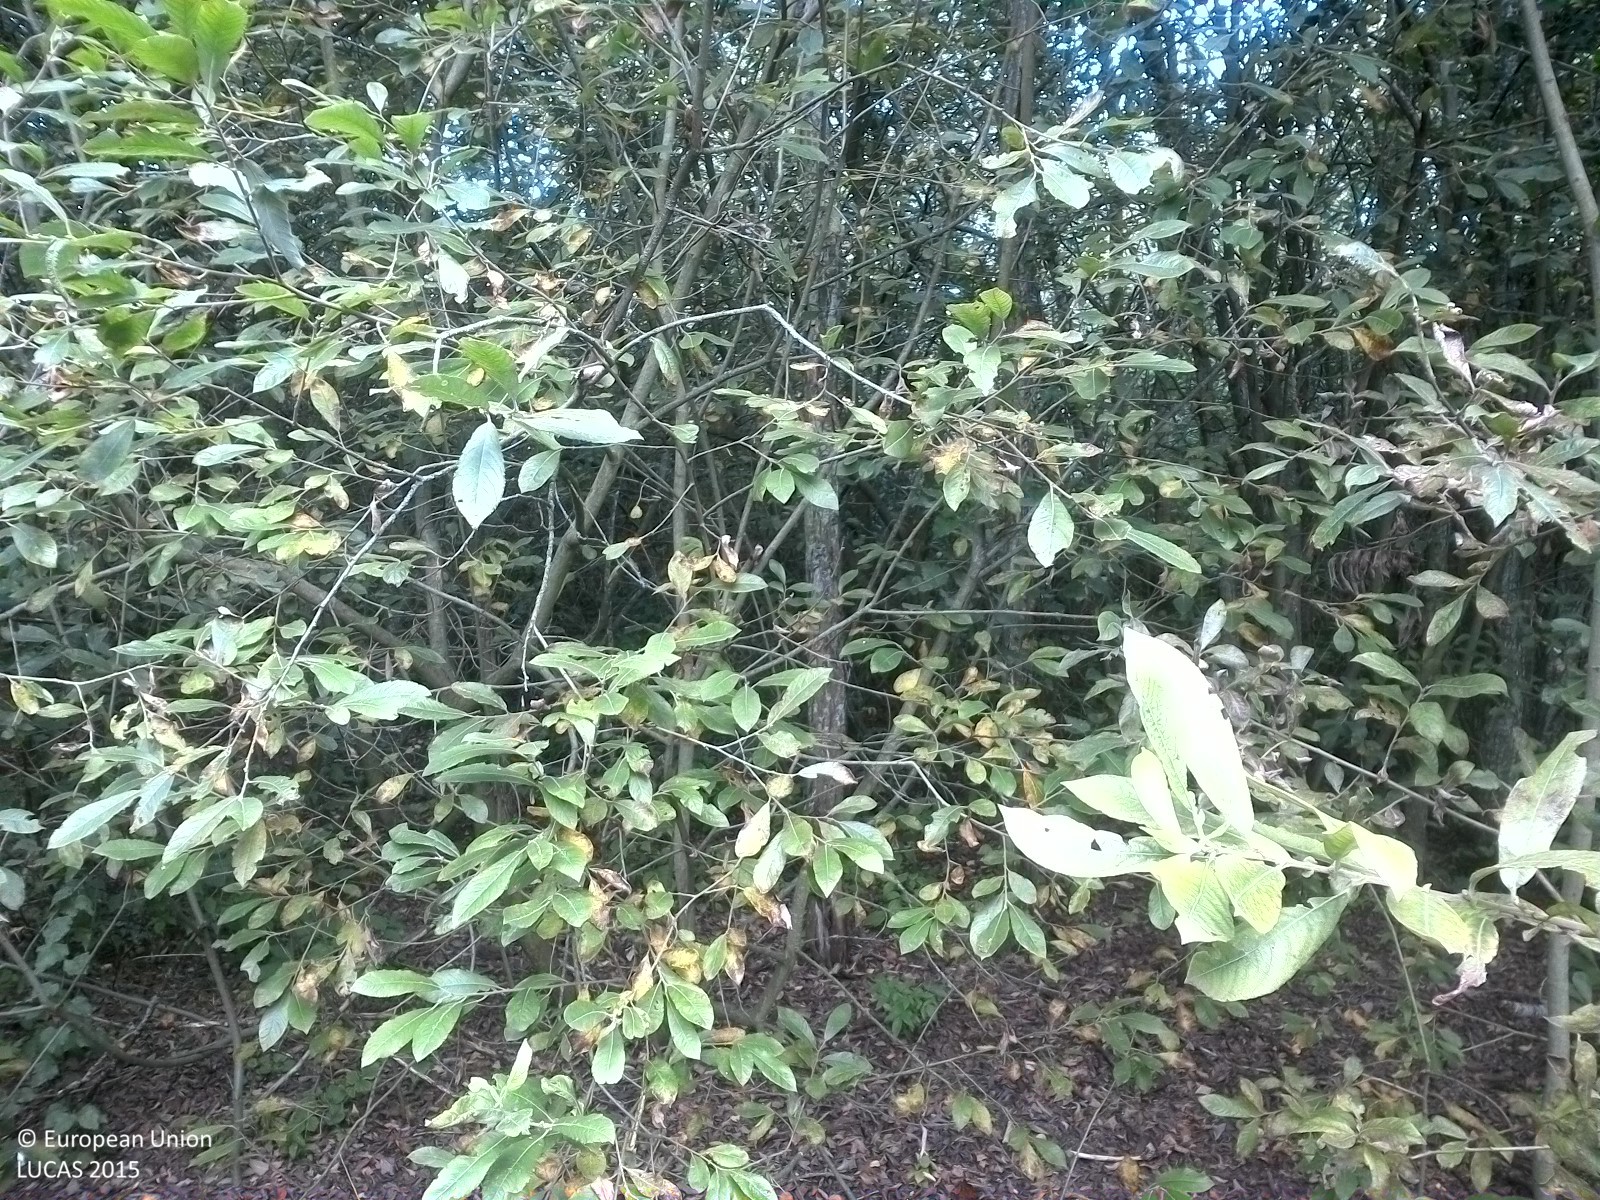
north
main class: Woodland
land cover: Broadleaved woodland
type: hemiboreal forest and nemoral coniferous forest and mixed broadleaved-coniferous forest
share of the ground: 50 - 75 %
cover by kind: broadleaved forest trees 60 %, herbaceous plants 20 %, shrubs 10 %, consolidated bare surface 10 %
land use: Semi-natural and natural areas not in use
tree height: > 5 m
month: September
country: SE
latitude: 58.5996
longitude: 16.2071
